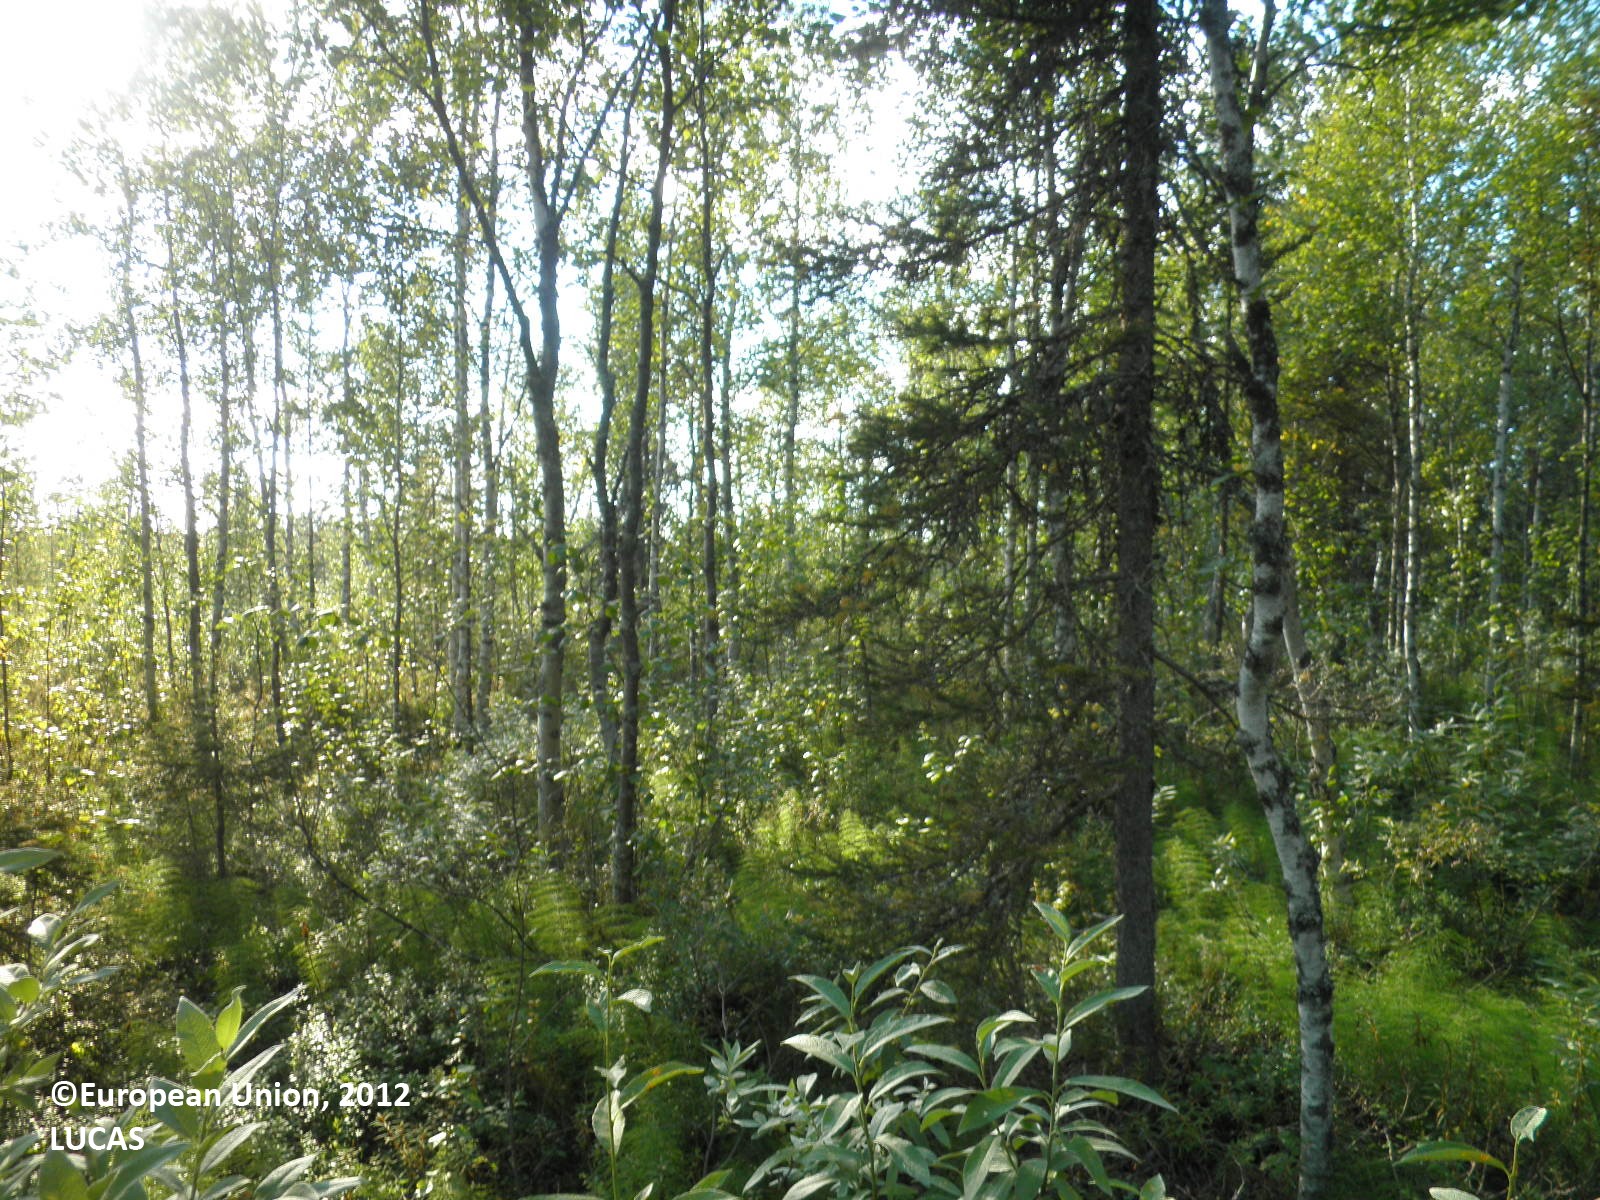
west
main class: Woodland
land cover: Spruce dominated mixed woodland
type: boreal forest
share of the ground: > 75 %
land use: Forestry
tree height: > 5 m
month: August
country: FI
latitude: 67.5382
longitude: 25.5049
